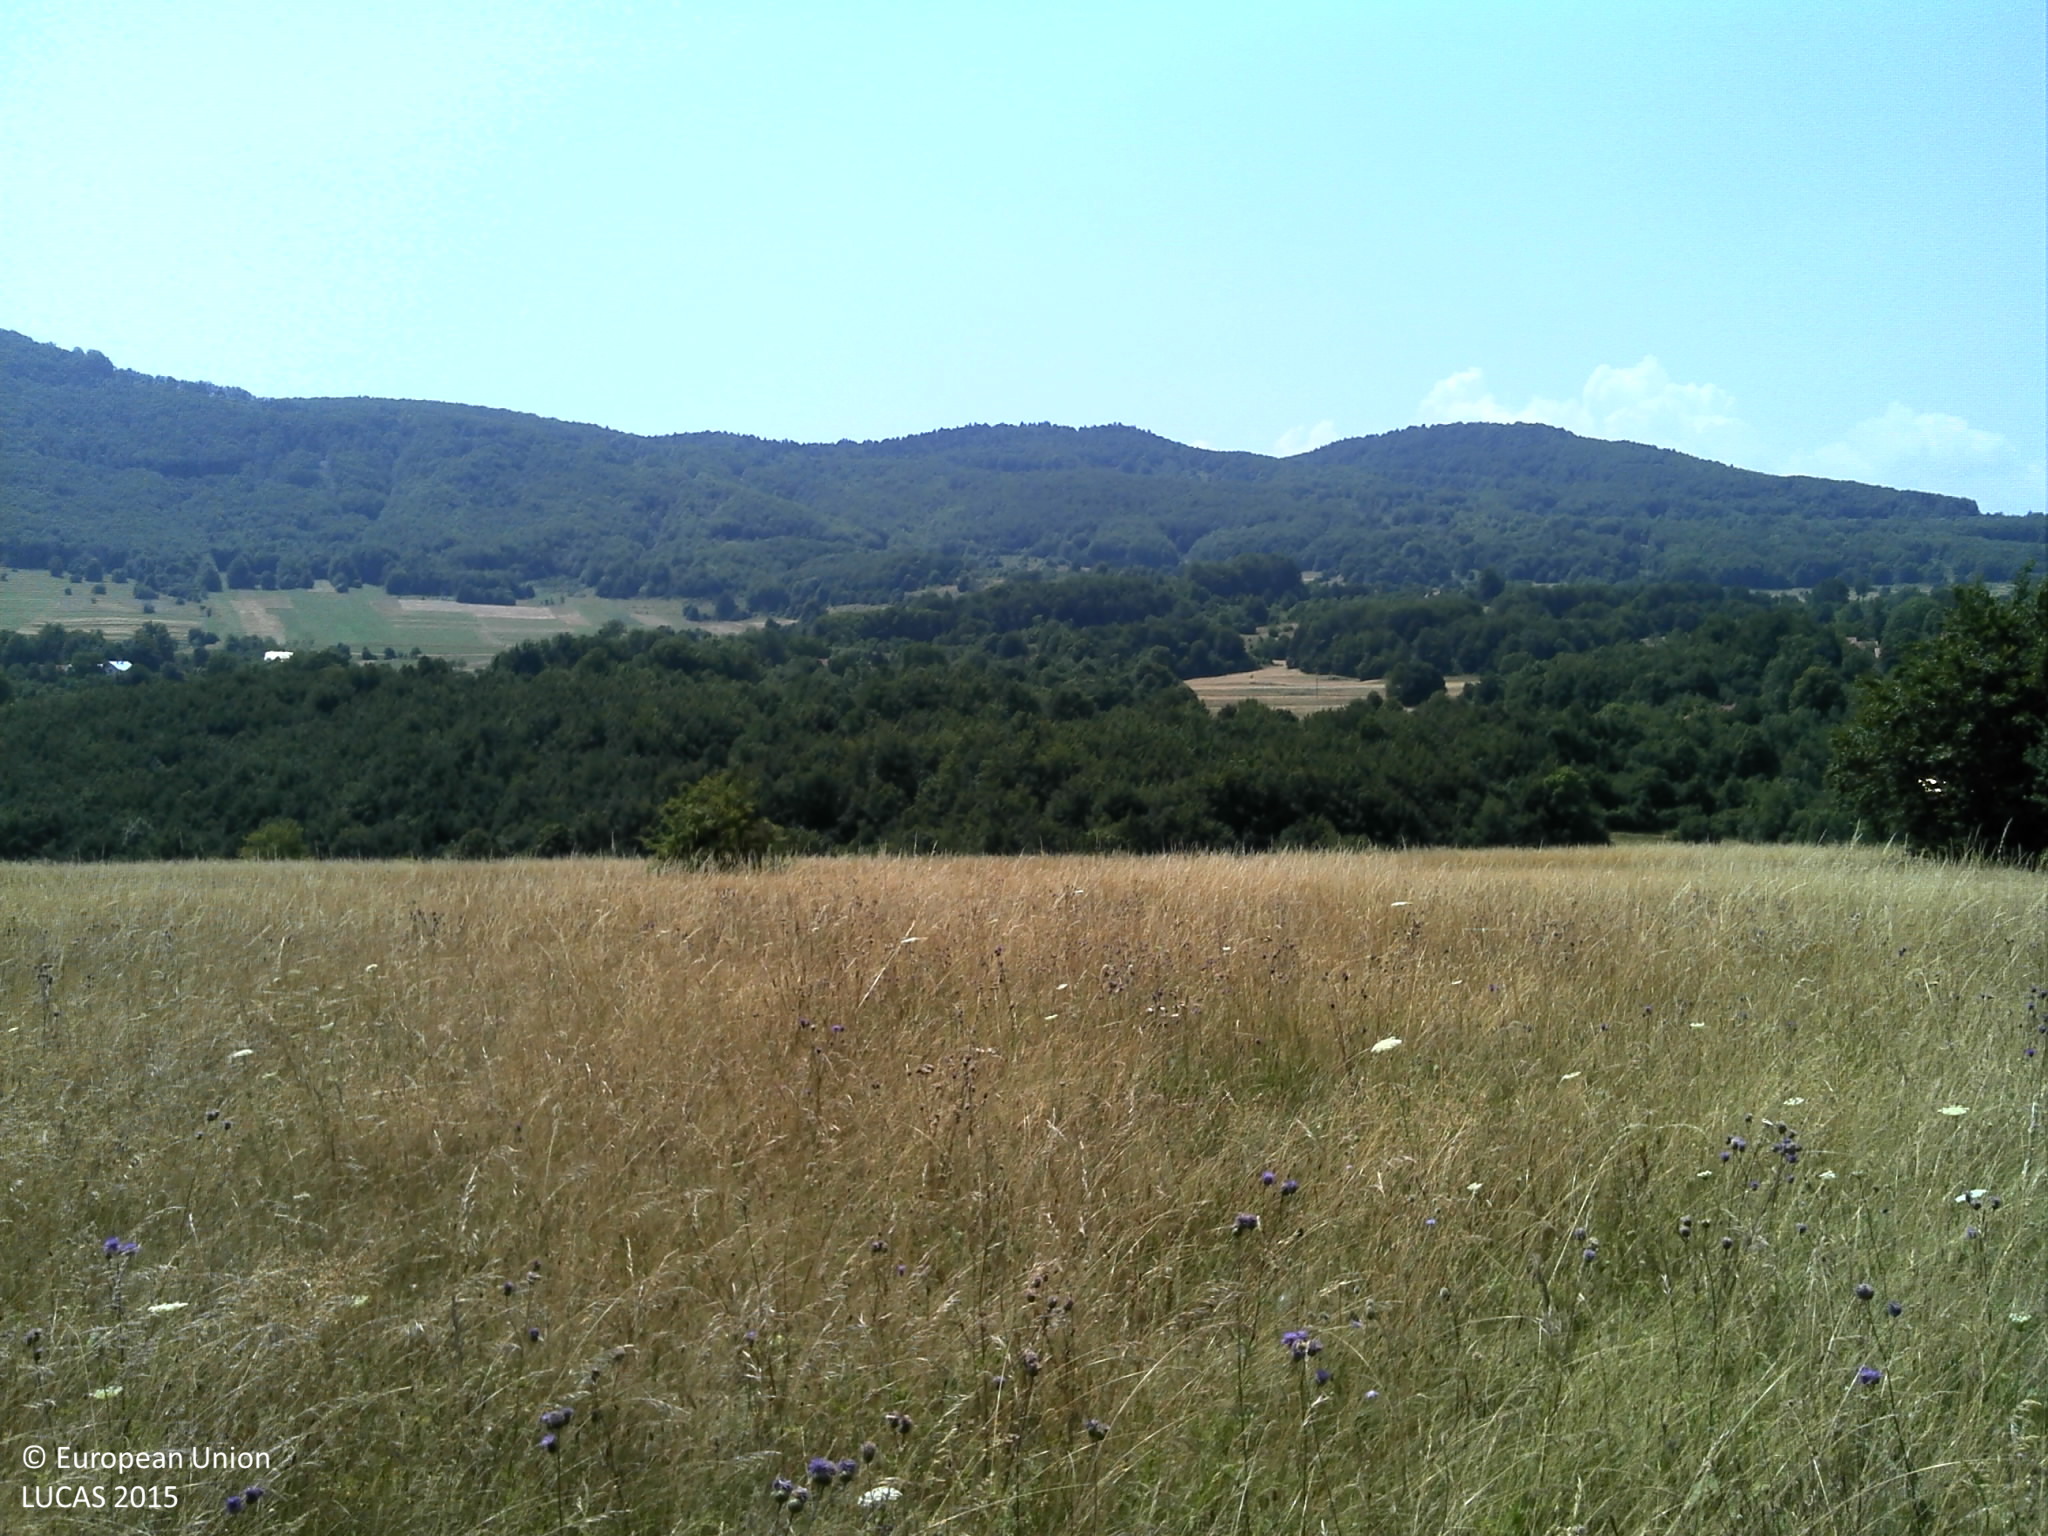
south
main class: Grassland
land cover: Grassland without tree/shrub cover
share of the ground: > 75 %
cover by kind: herbaceous plants 100 %
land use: Semi-natural and natural areas not in use
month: July
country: HR
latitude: 45.0121
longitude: 15.2604
